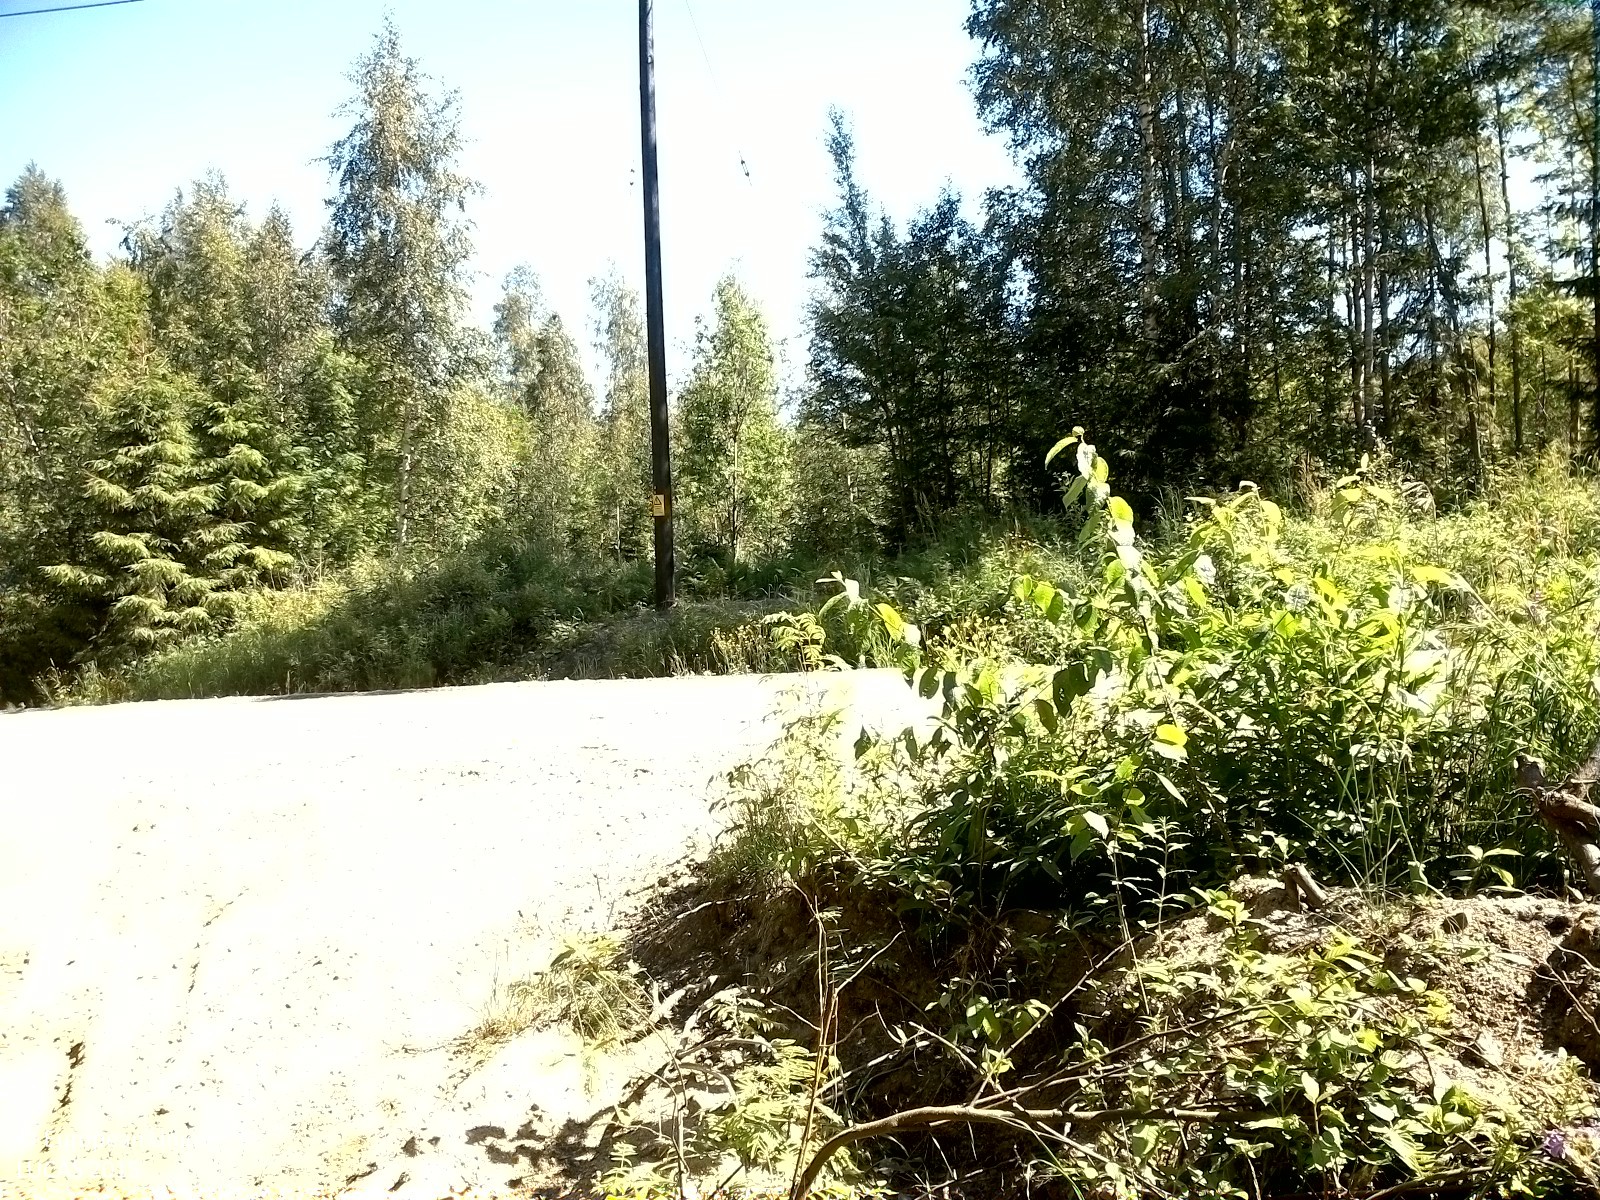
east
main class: Woodland
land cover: Broadleaved woodland
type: boreal forest
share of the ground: 50 - 75 %
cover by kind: broadleaved forest trees 70 %, herbaceous plants 30 %
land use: Semi-natural and natural areas not in use
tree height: > 5 m
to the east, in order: Paved roads, cycling and walking lanes; Ditches and canals; Electric lines; Grassland with sparse tree/shrub cover; Broadleaved woodland; Grass margins; Broadleaved woodland; Grass margins; Spruce dominated mixed woodland; Other mixed woodland; Spruce dominated coniferous woodland; Broadleaved woodland
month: July
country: SE
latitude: 62.2732
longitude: 16.8973
